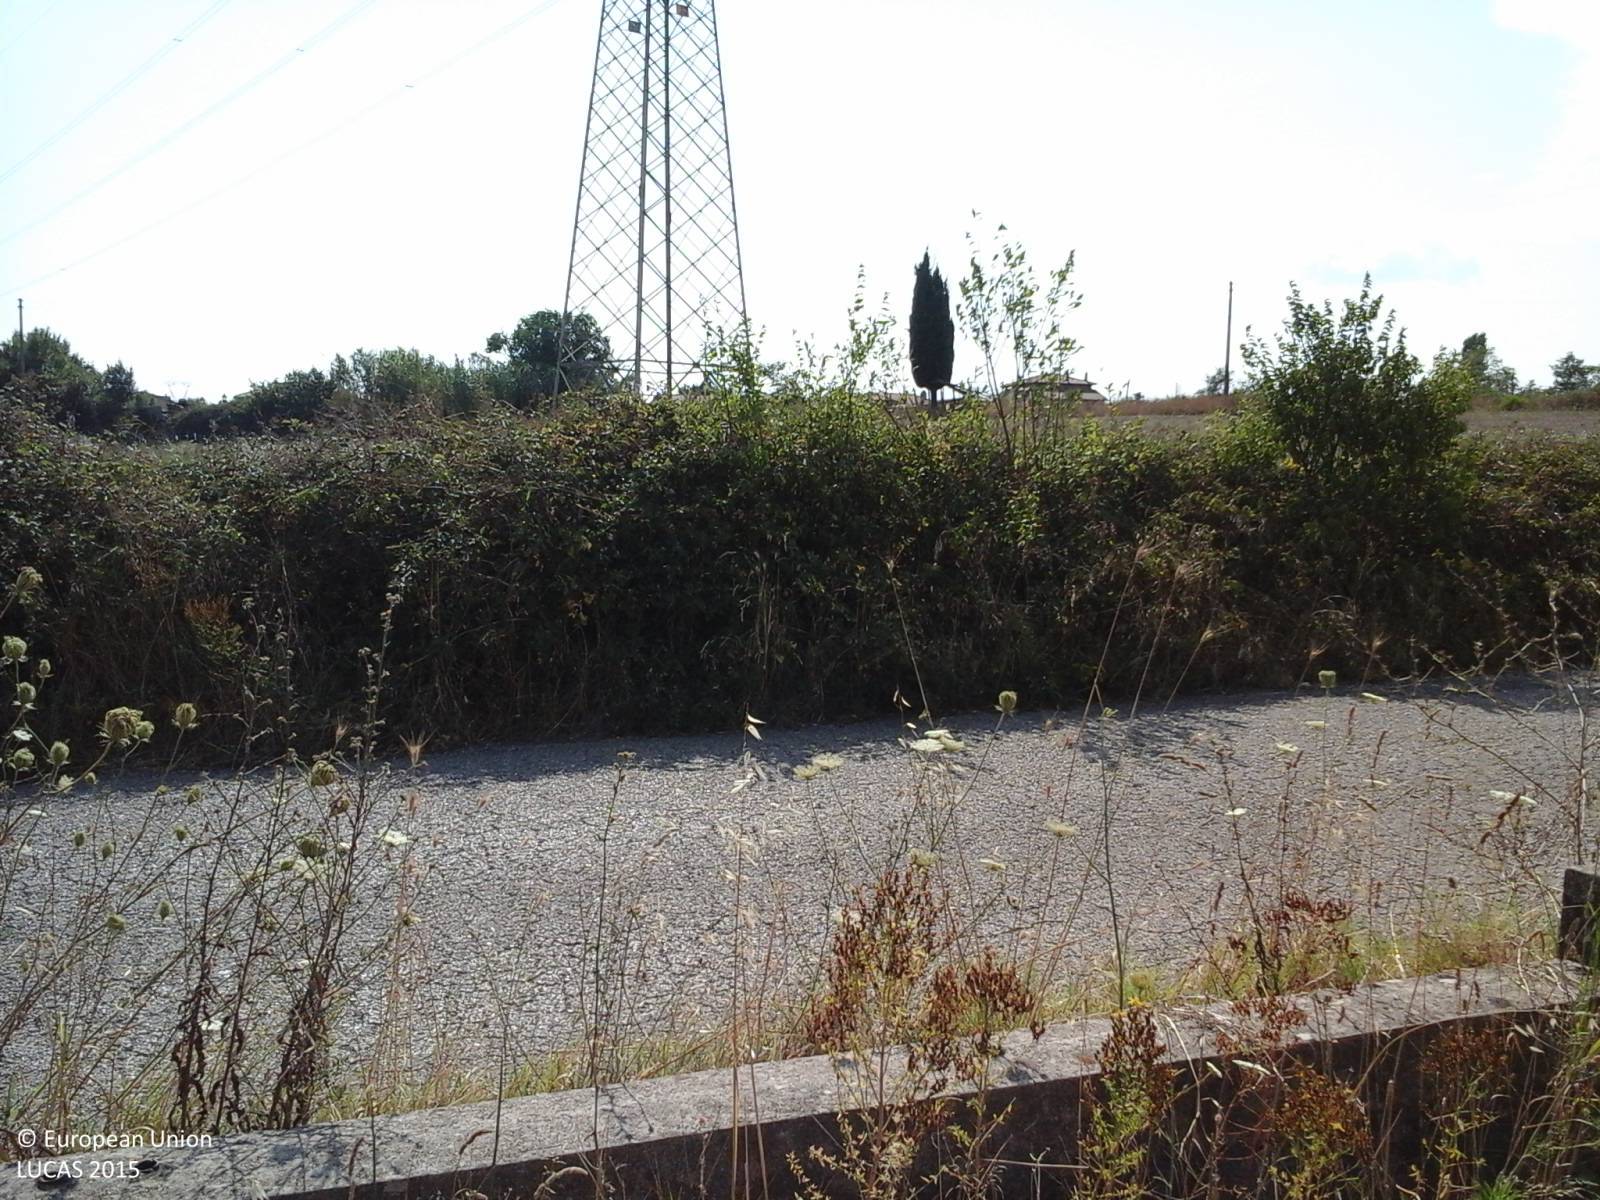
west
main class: Grassland
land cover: Grassland without tree/shrub cover
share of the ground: > 75 %
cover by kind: herbaceous plants 100 %
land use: Manufacturing of food, beverages and tobacco products
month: July
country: IT
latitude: 42.0677
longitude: 12.3000
